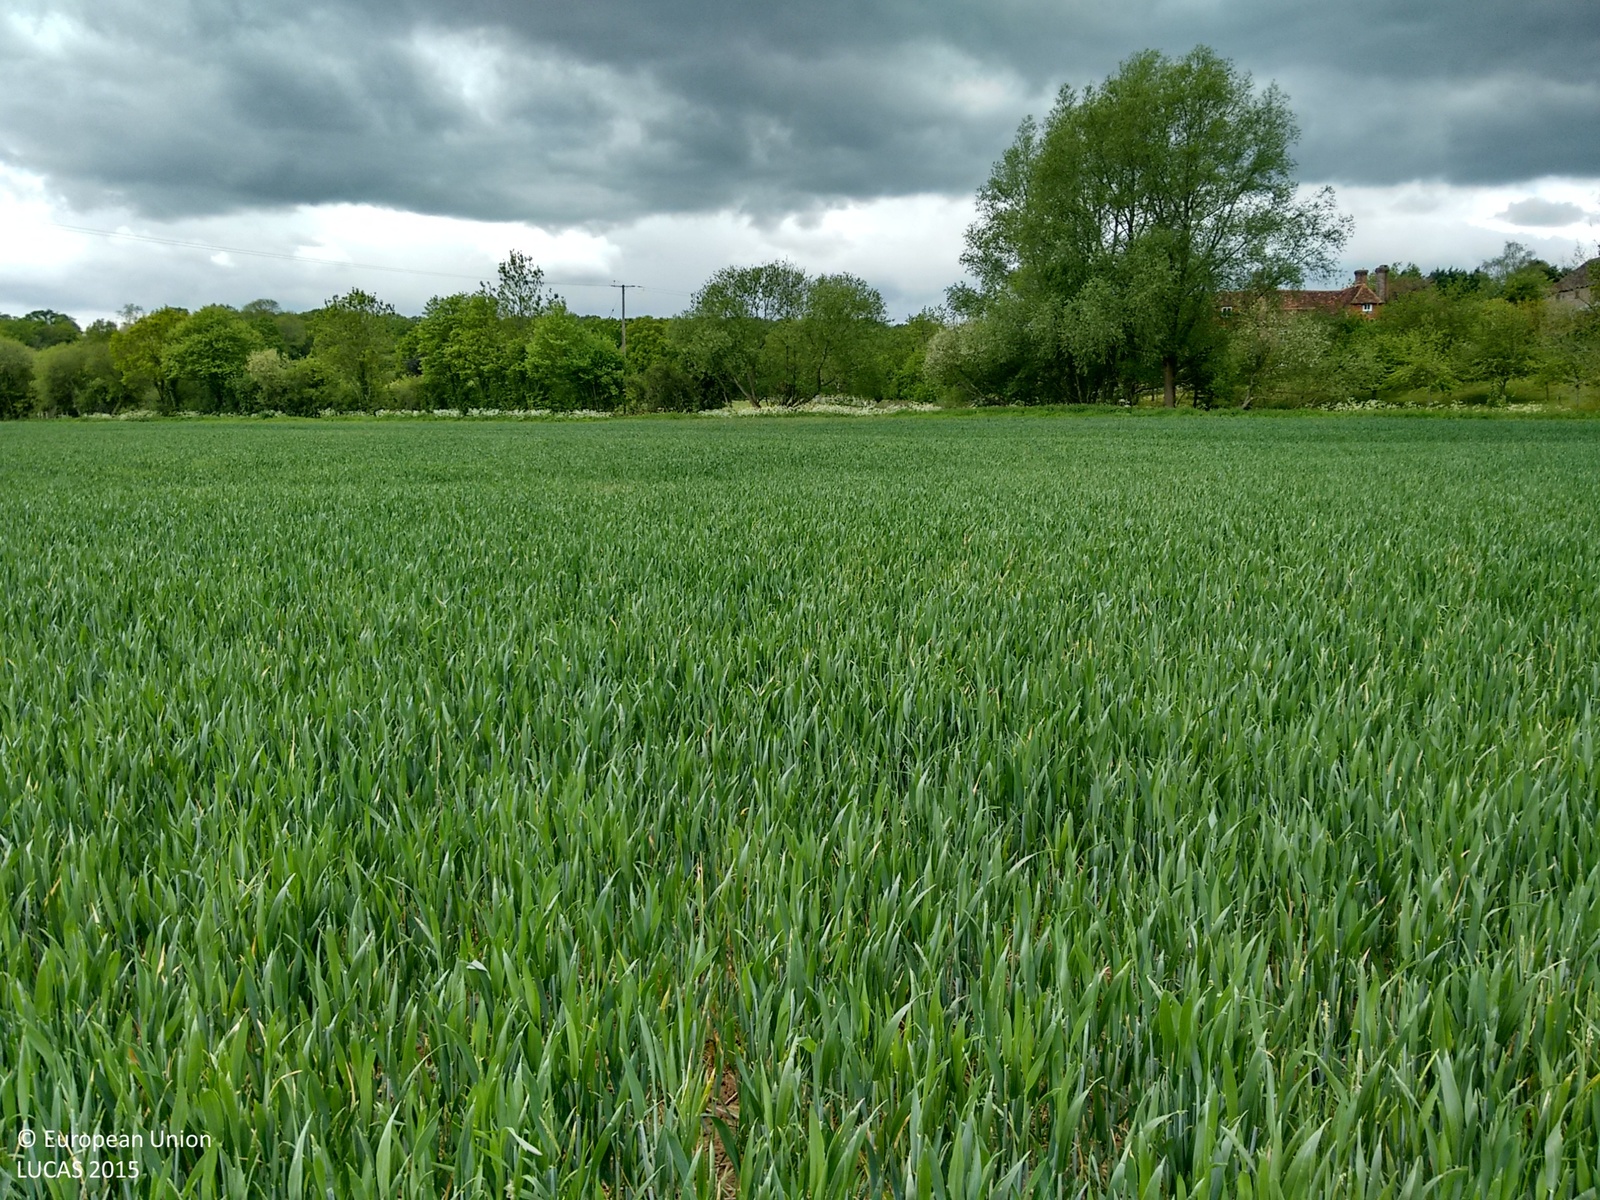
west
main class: Cropland
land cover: Common wheat
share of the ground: > 75 %
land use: Agriculture (excluding fallow land and kitchen gardens)
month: May
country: GB
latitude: 51.1159
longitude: 0.1547
